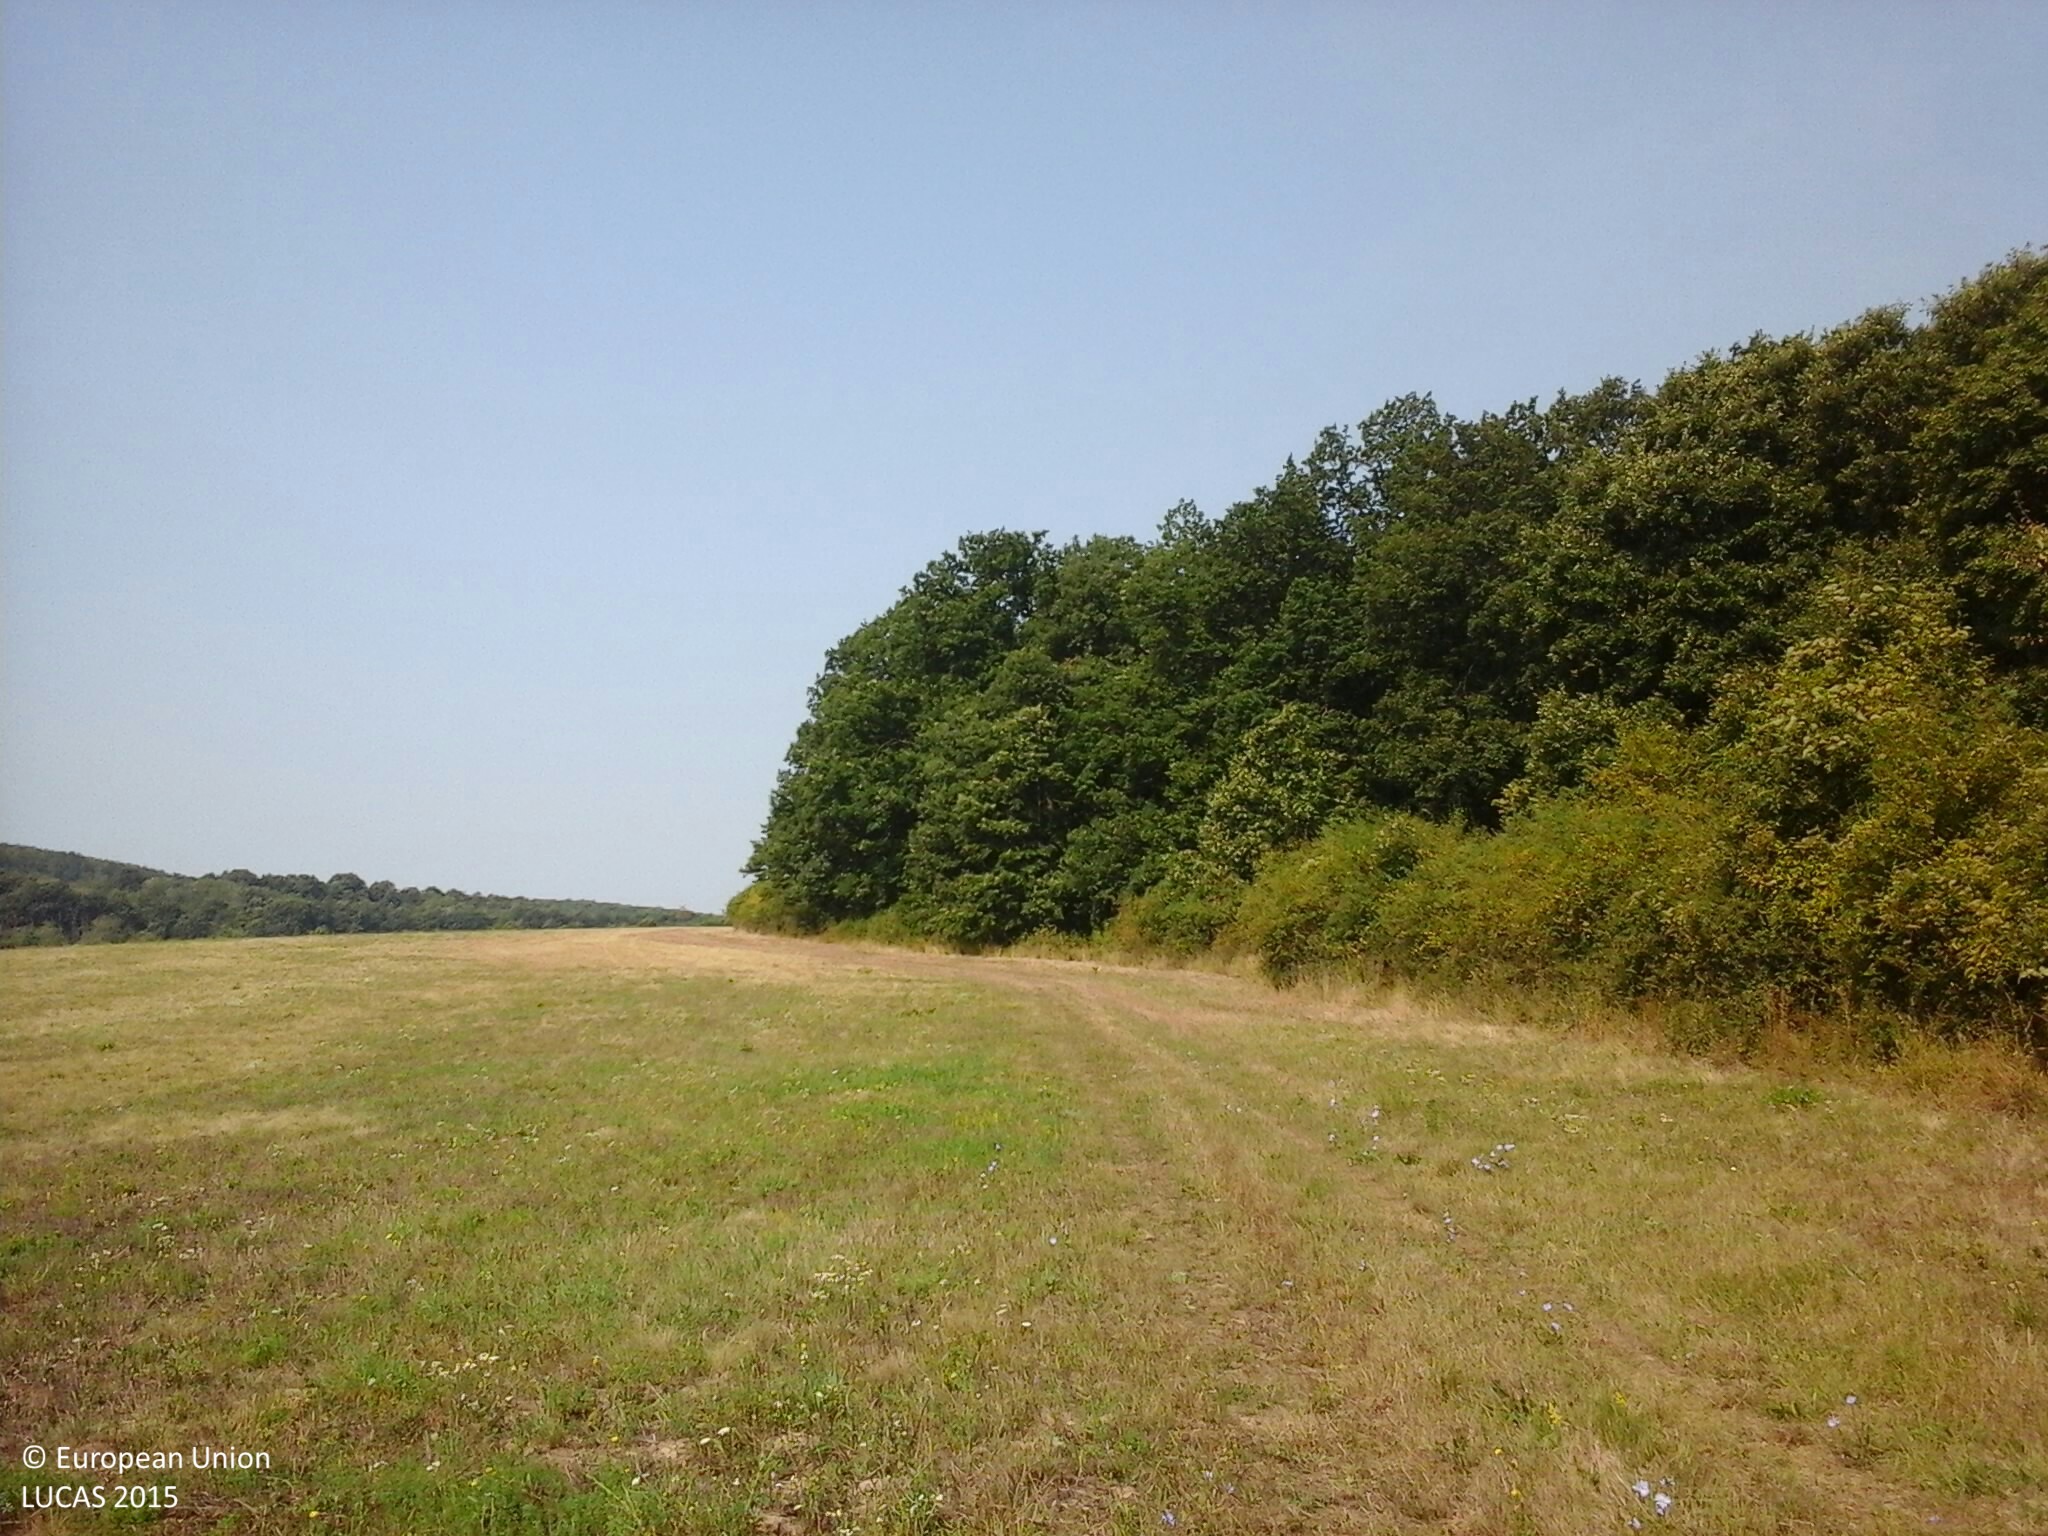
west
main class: Grassland
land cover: Grassland without tree/shrub cover
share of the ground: > 75 %
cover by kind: herbaceous plants 100 %
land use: Agriculture (excluding fallow land and kitchen gardens)
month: August
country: HU
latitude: 47.8739
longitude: 19.2057
